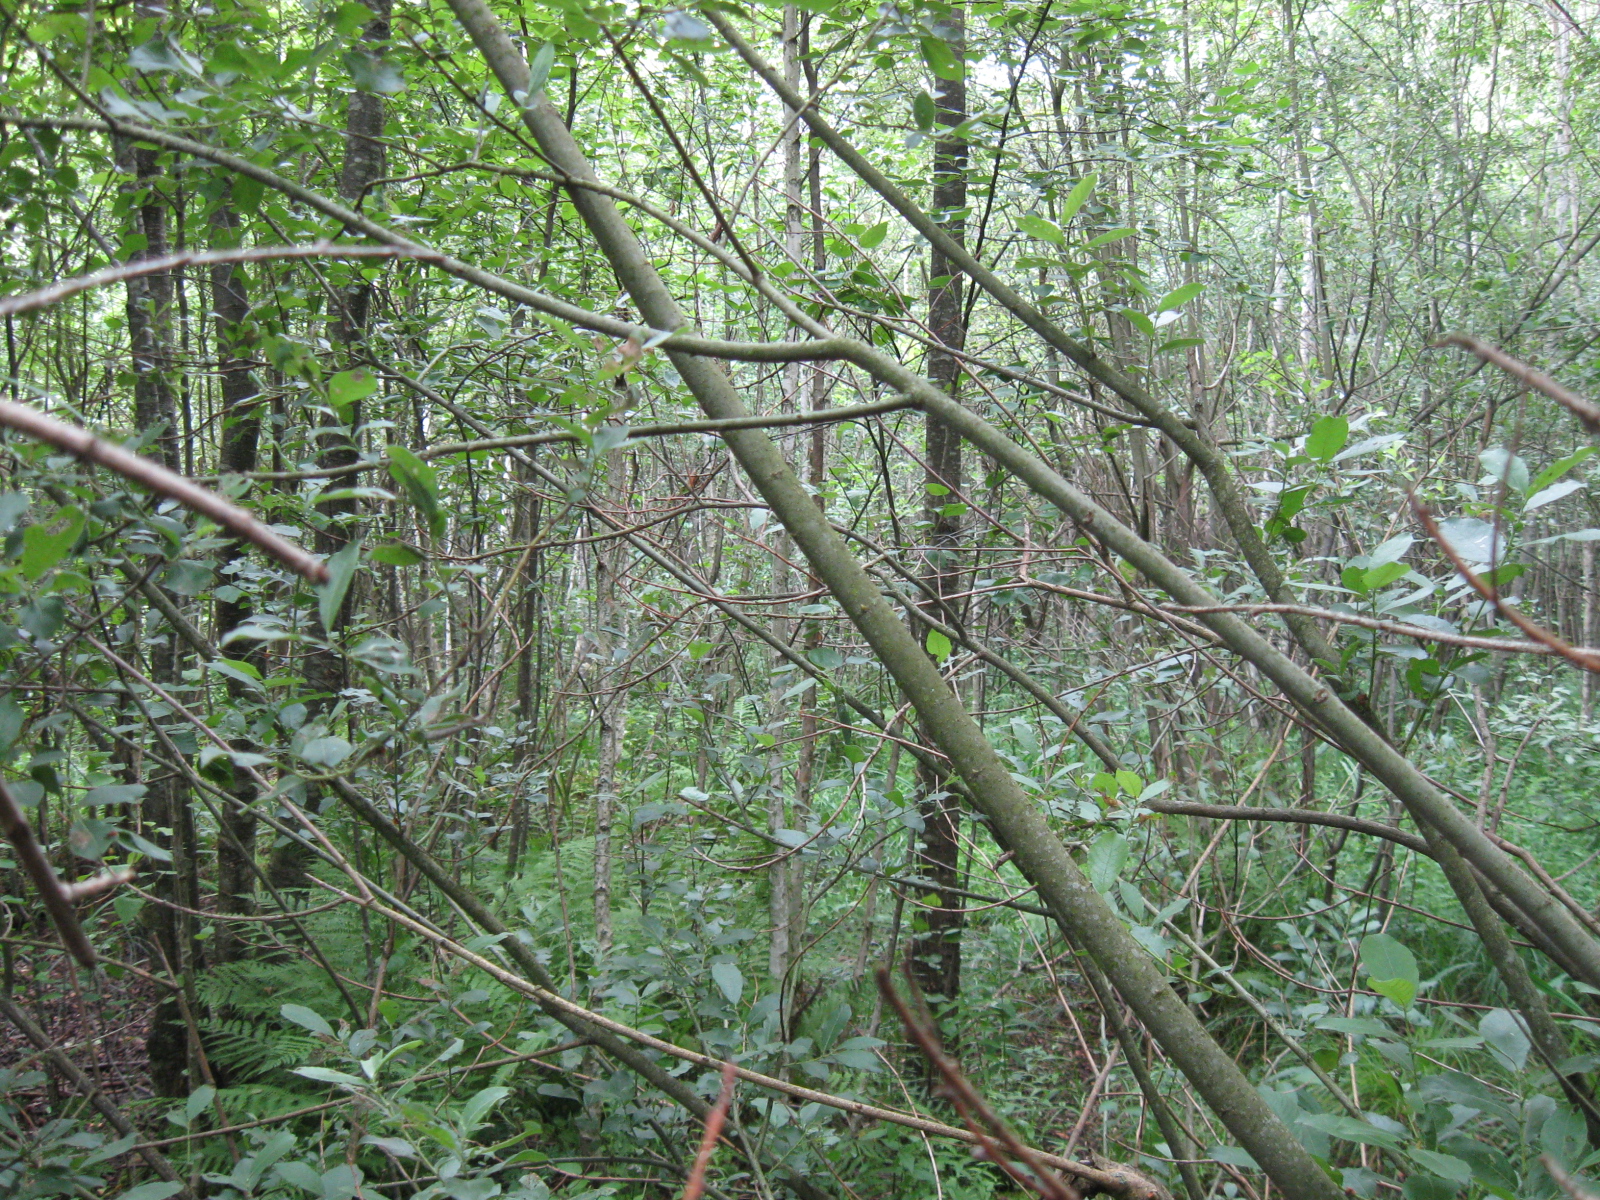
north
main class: Woodland
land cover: Broadleaved woodland
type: floodplain forest
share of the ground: > 75 %
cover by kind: broadleaved forest trees 90 %, herbaceous plants 5 %, unconsolidated bare surface 5 %
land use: Forestry
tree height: > 5 m
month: July
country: LT
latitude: 55.0622
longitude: 23.7223
